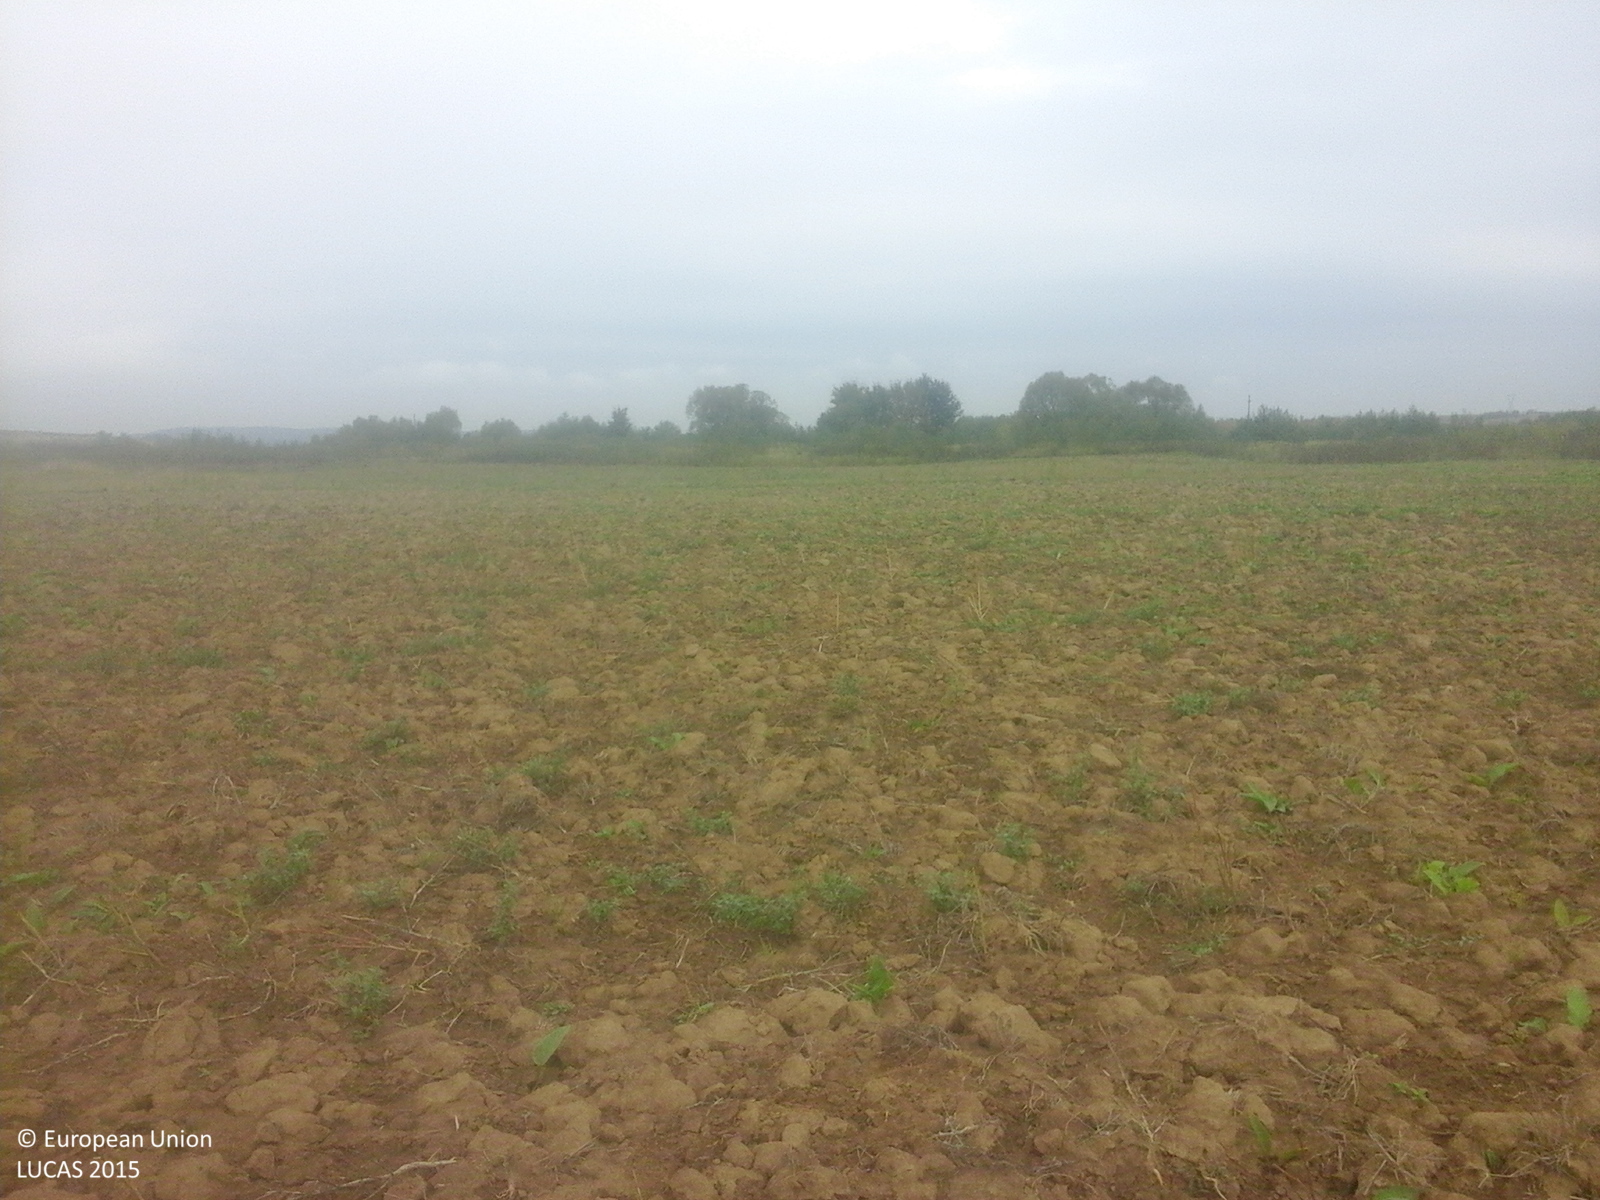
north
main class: Cropland
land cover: Maize
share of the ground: < 10 %
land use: Agriculture (excluding fallow land and kitchen gardens)
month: September
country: RO
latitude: 45.8456
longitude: 22.0814
